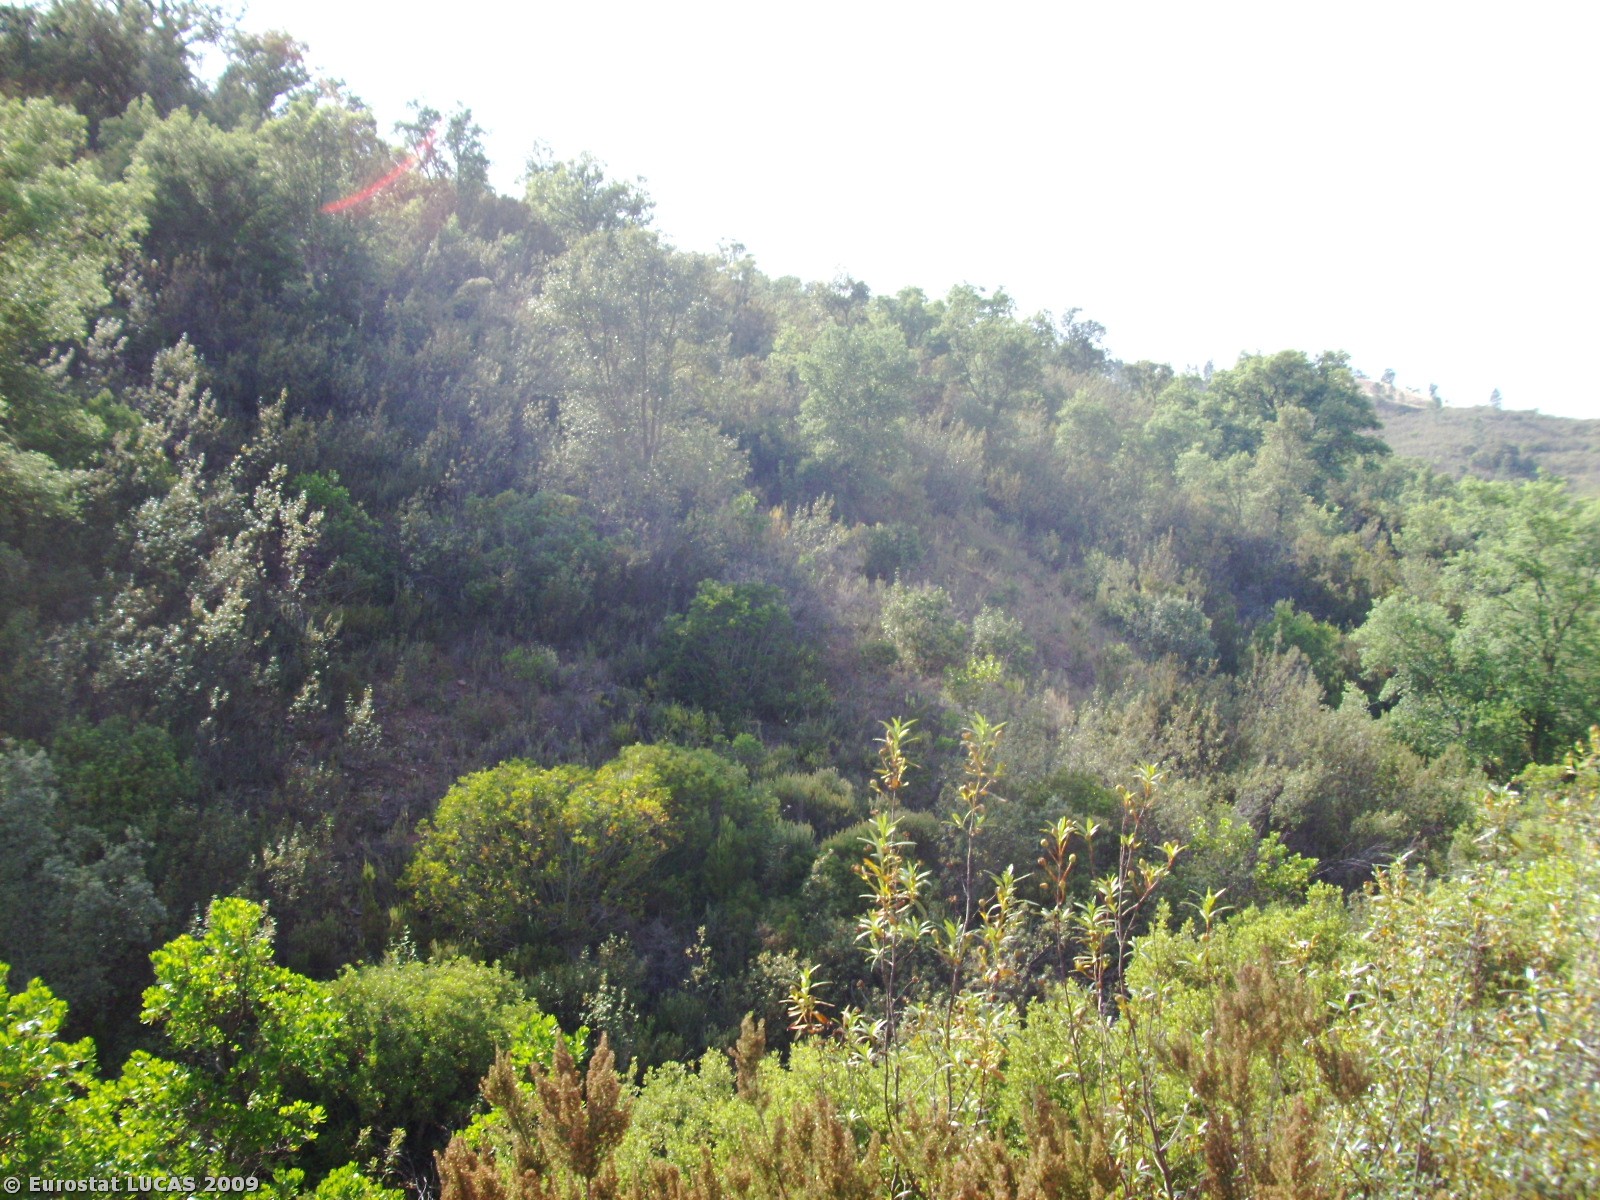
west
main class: Shrubland
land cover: Shrubland with sparse tree cover
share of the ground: > 75 %
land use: Unused
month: May
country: PT
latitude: 37.3140
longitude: -8.2683
